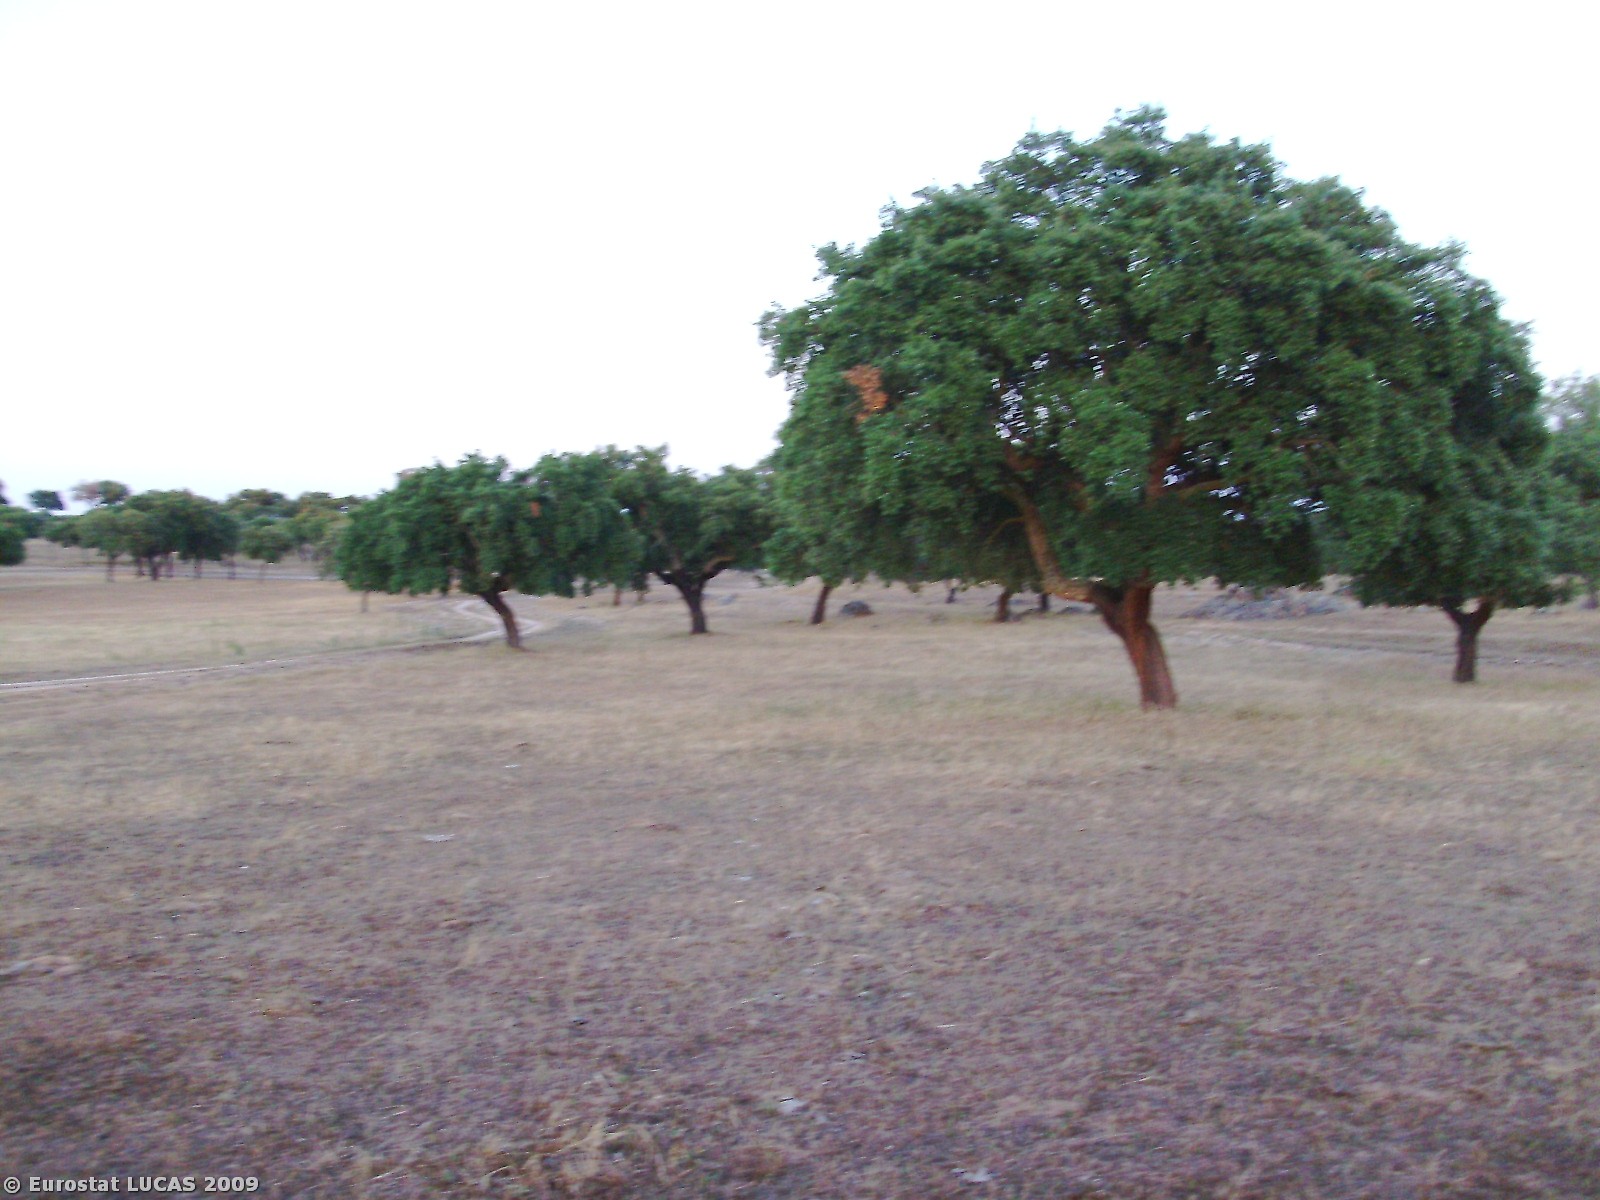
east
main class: Grassland
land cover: Grassland with sparse tree/shrub cover
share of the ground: > 75 %
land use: Agriculture (excluding fallow land and kitchen gardens)
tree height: > 5 m
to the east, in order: Grassland with sparse tree/shrub cover; Broadleaved woodland; Fences; Broadleaved woodland
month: May
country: PT
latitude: 38.9518
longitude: -7.3297
